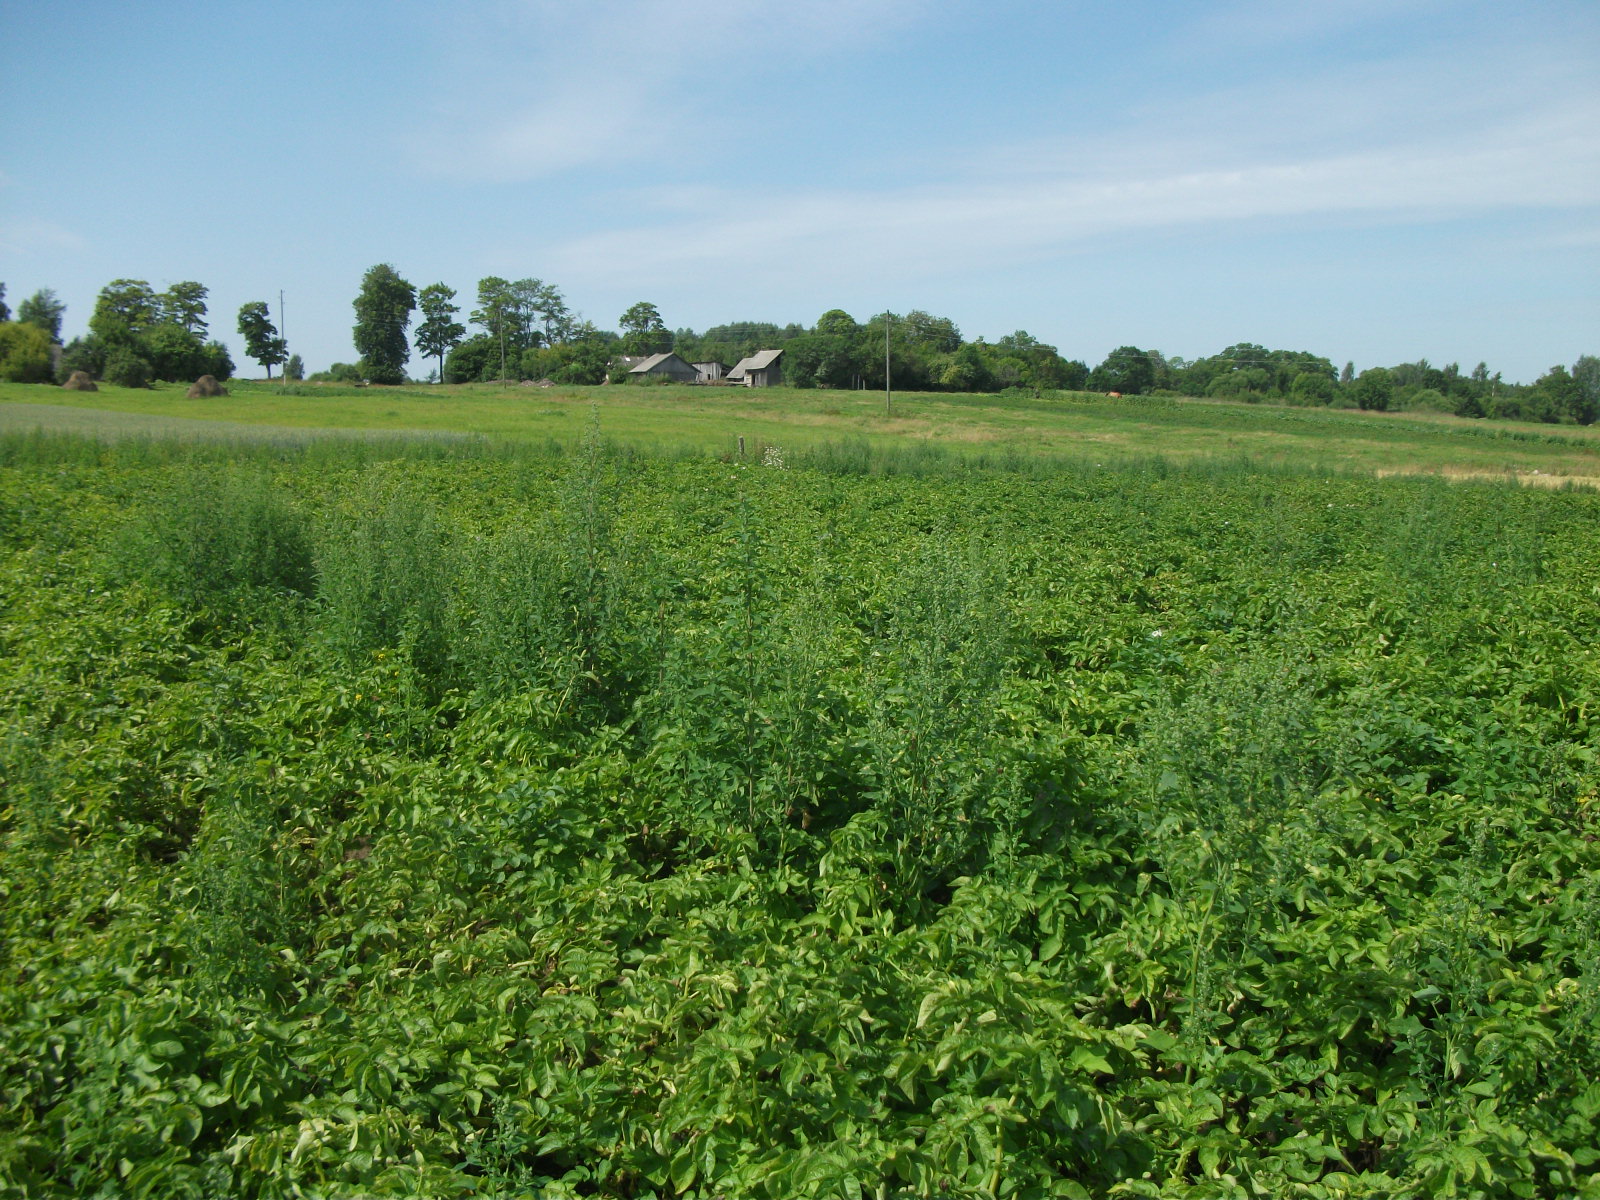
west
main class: Cropland
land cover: Potatoes
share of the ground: > 75 %
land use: Agriculture (excluding fallow land and kitchen gardens)
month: August
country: LV
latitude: 57.1319
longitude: 26.6539
